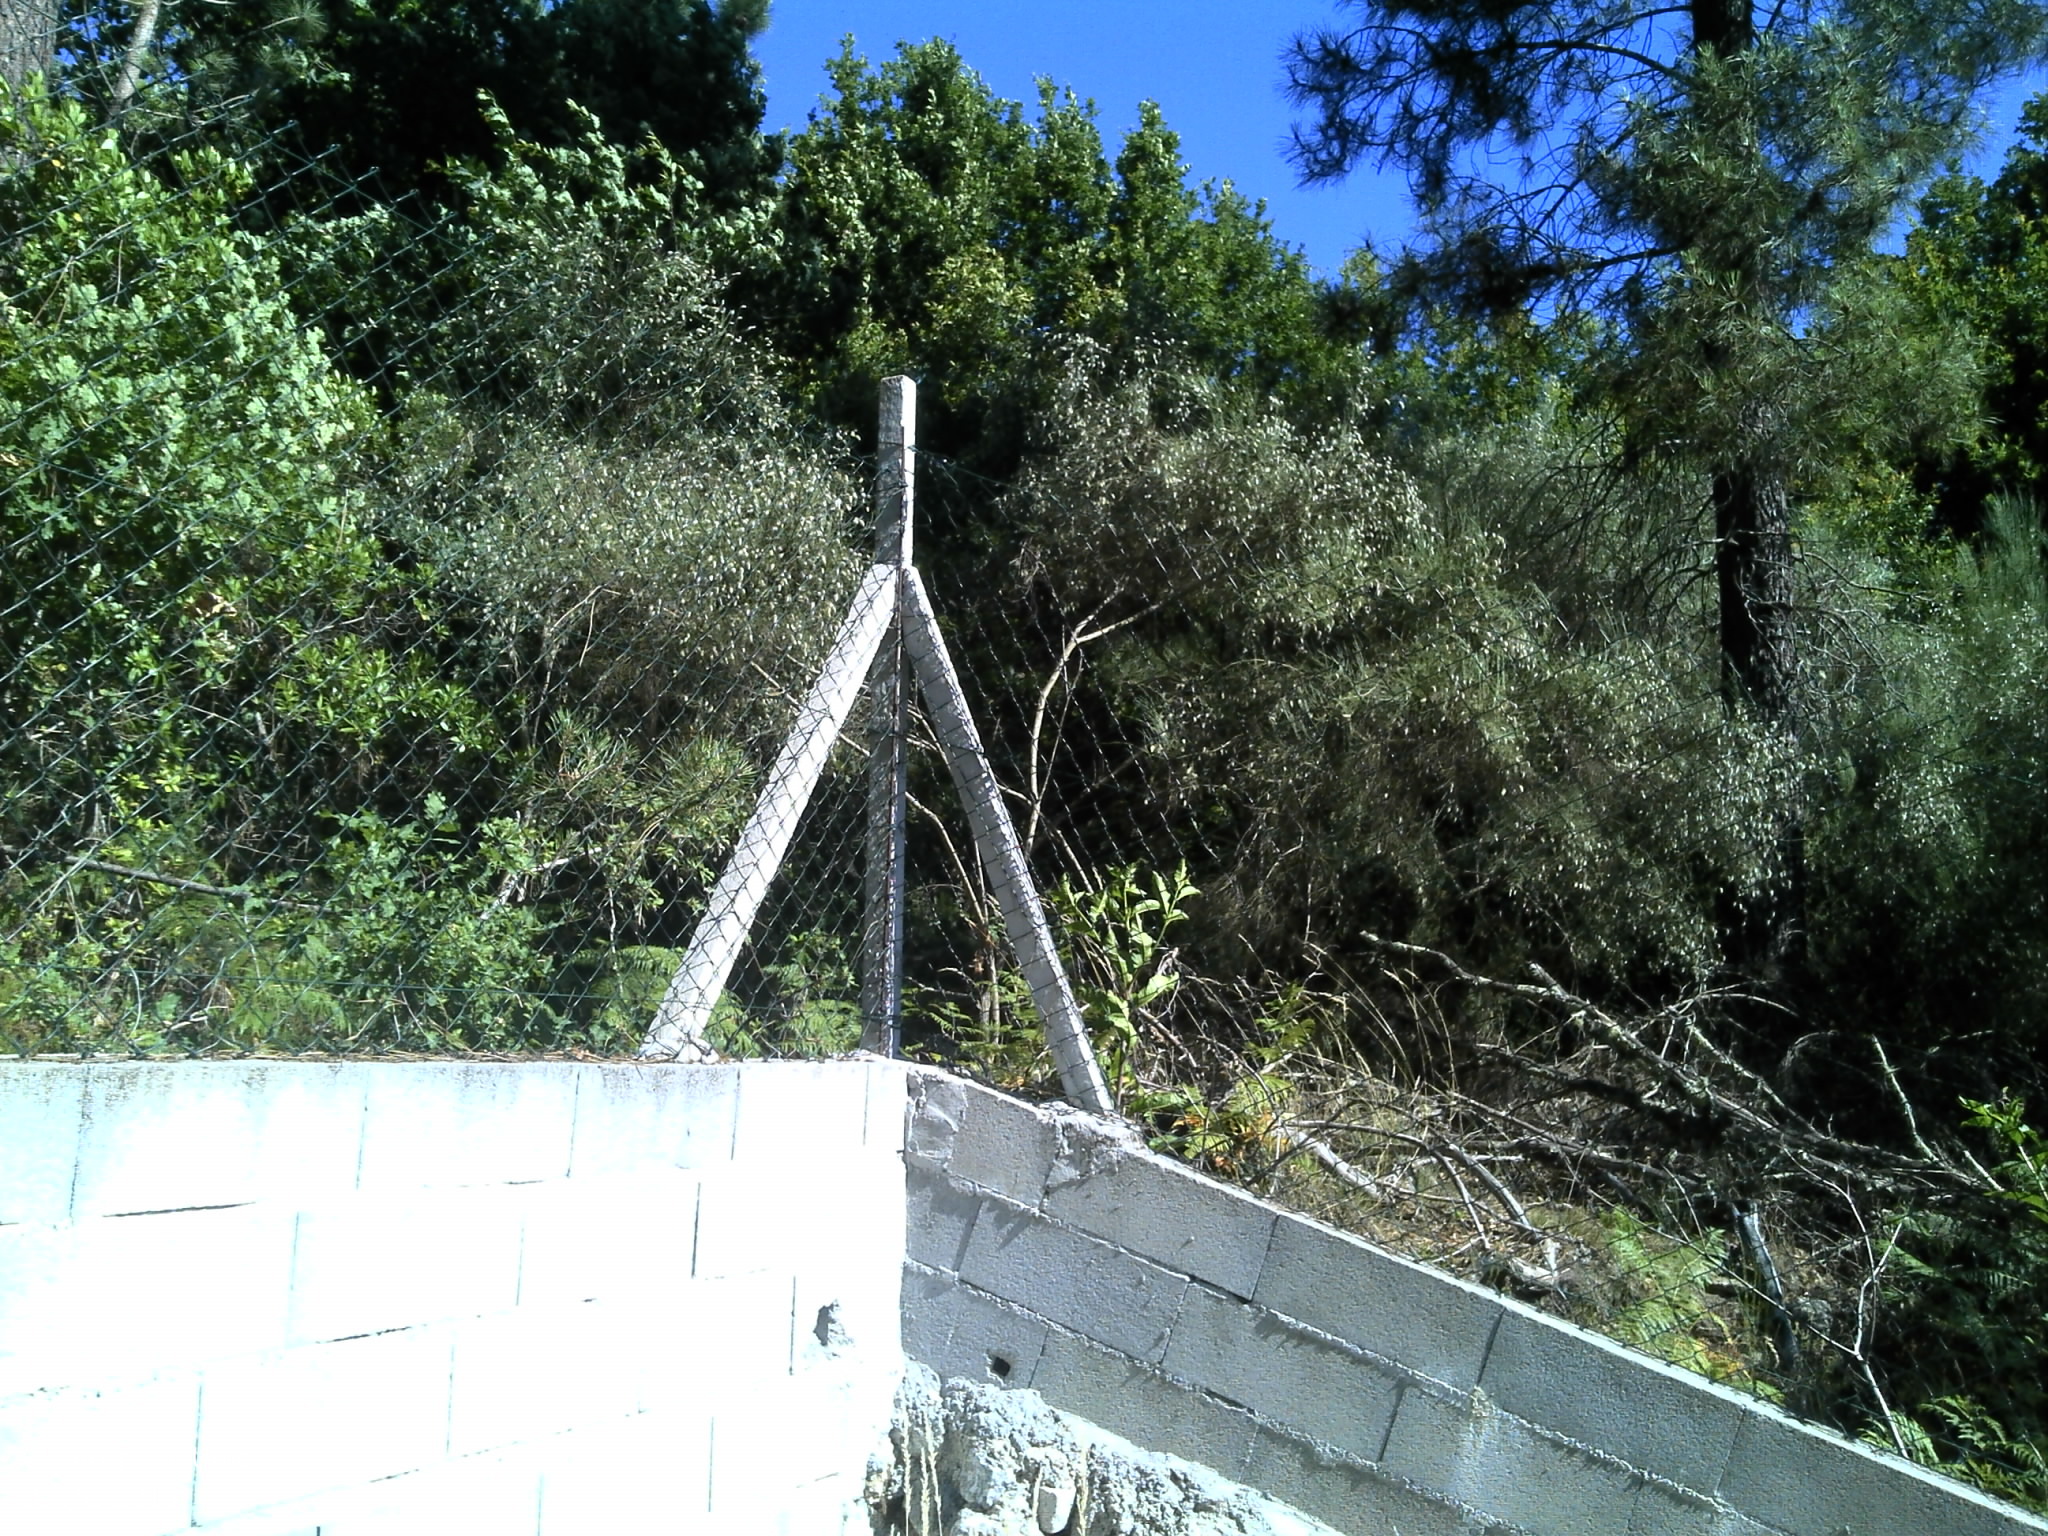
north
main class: Woodland
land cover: Broadleaved woodland
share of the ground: > 75 %
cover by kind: broadleaved forest trees 75 %, shrubs 25 %
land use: Forestry
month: June
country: PT
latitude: 40.6743
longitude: -8.0029
